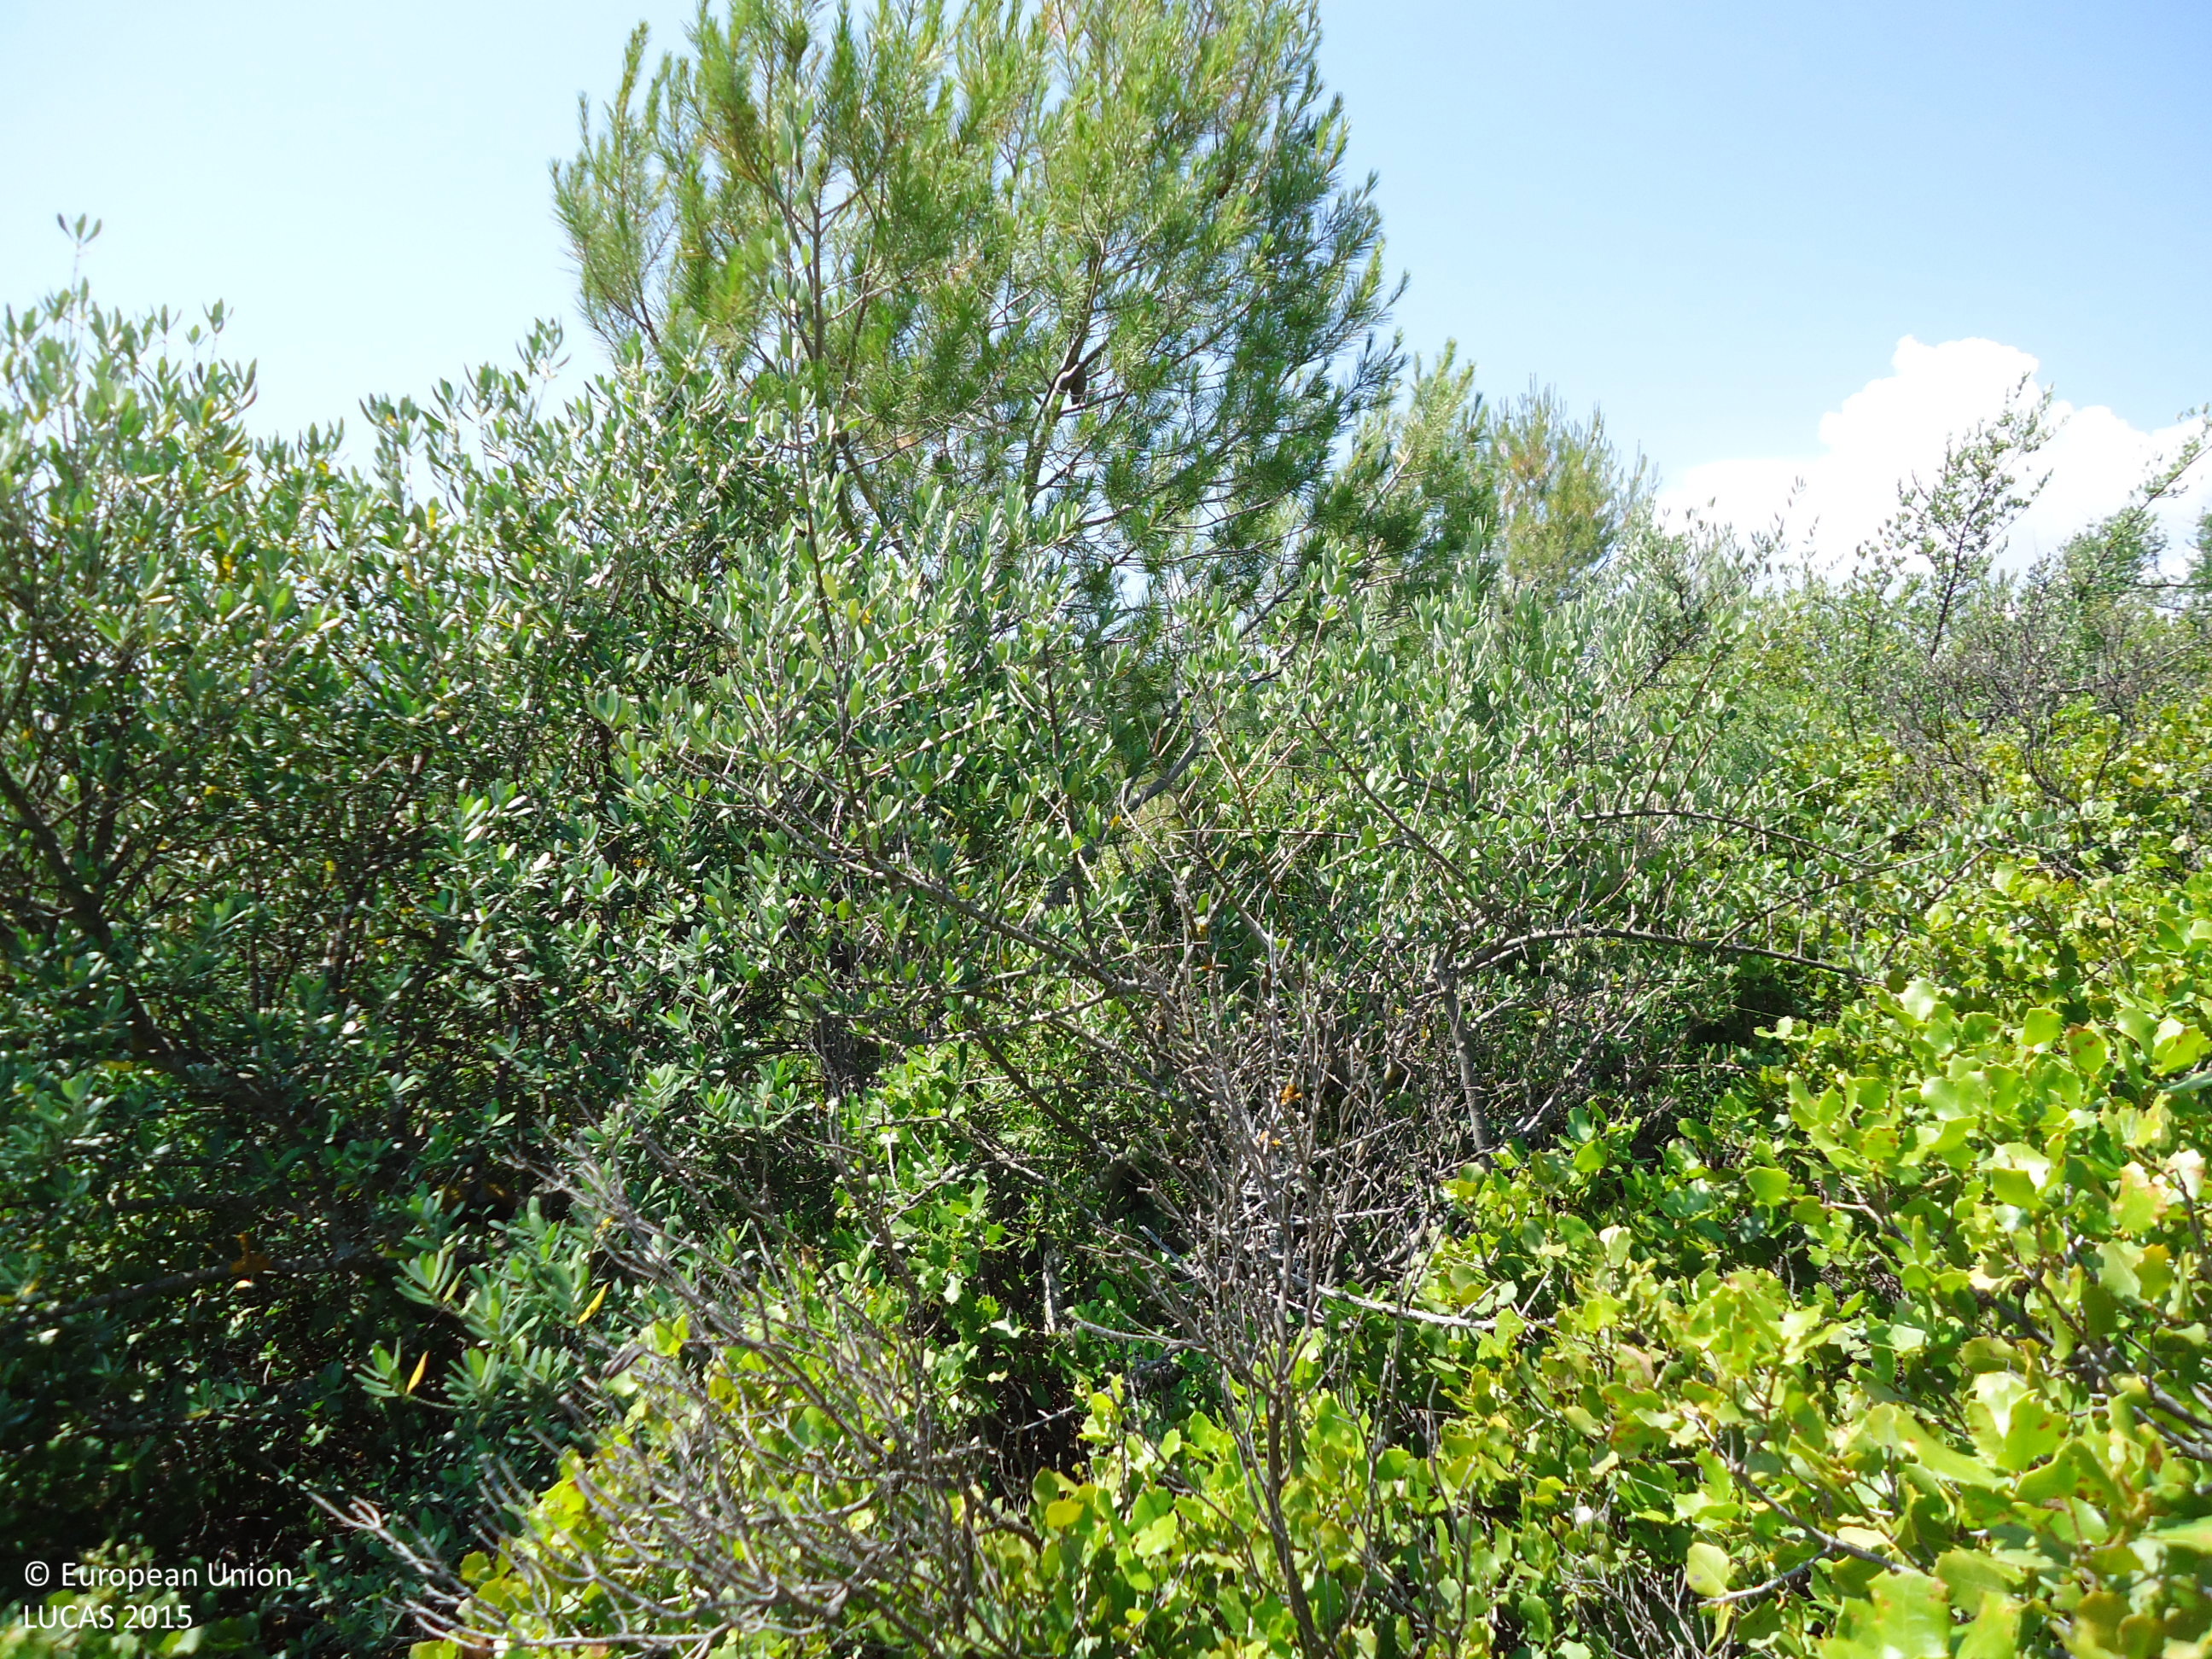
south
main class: Shrubland
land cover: Shrubland with sparse tree cover
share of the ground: > 75 %
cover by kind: shrubs 90 %, broadleaved forest trees 5 %, consolidated bare surface 5 %
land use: Semi-natural and natural areas not in use
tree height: < 5 m
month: June
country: ES
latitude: 36.7786
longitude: -4.9553
